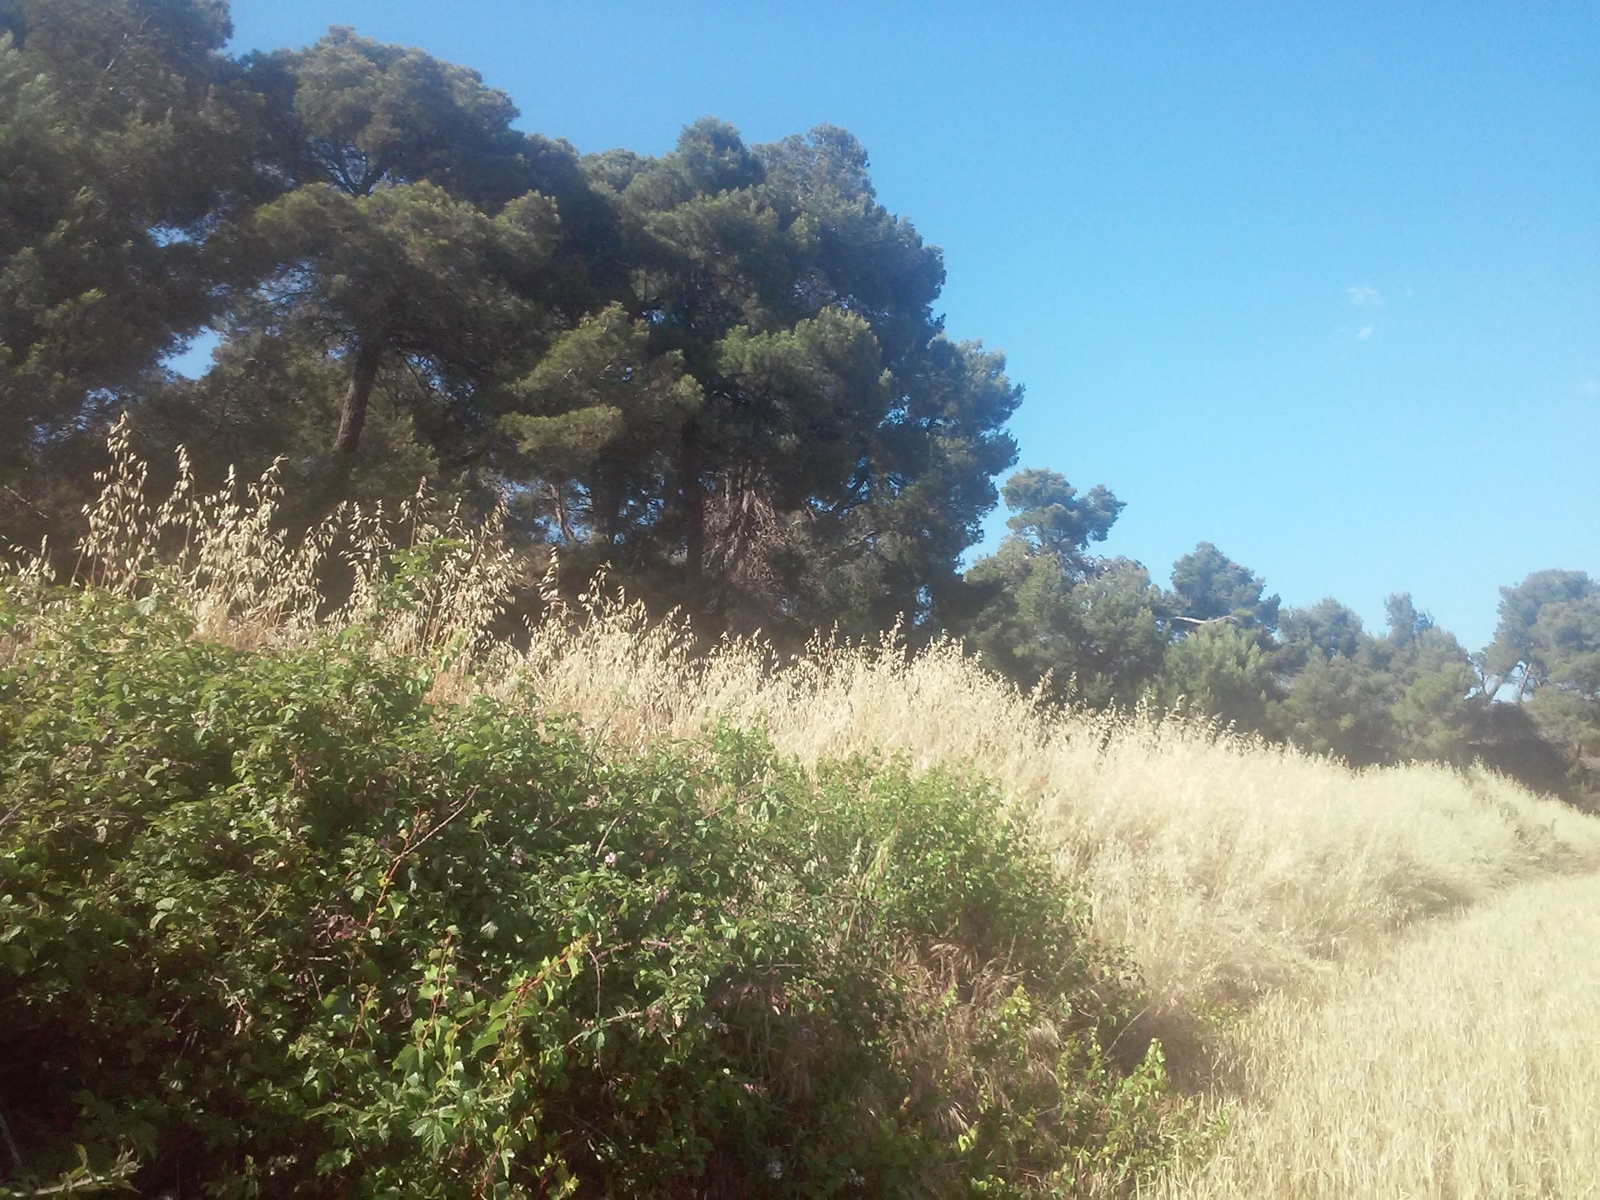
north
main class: Cropland
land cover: Barley
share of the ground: 50 - 75 %
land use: Agriculture (excluding fallow land and kitchen gardens)
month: June
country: ES
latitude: 41.4724
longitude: 1.2139
